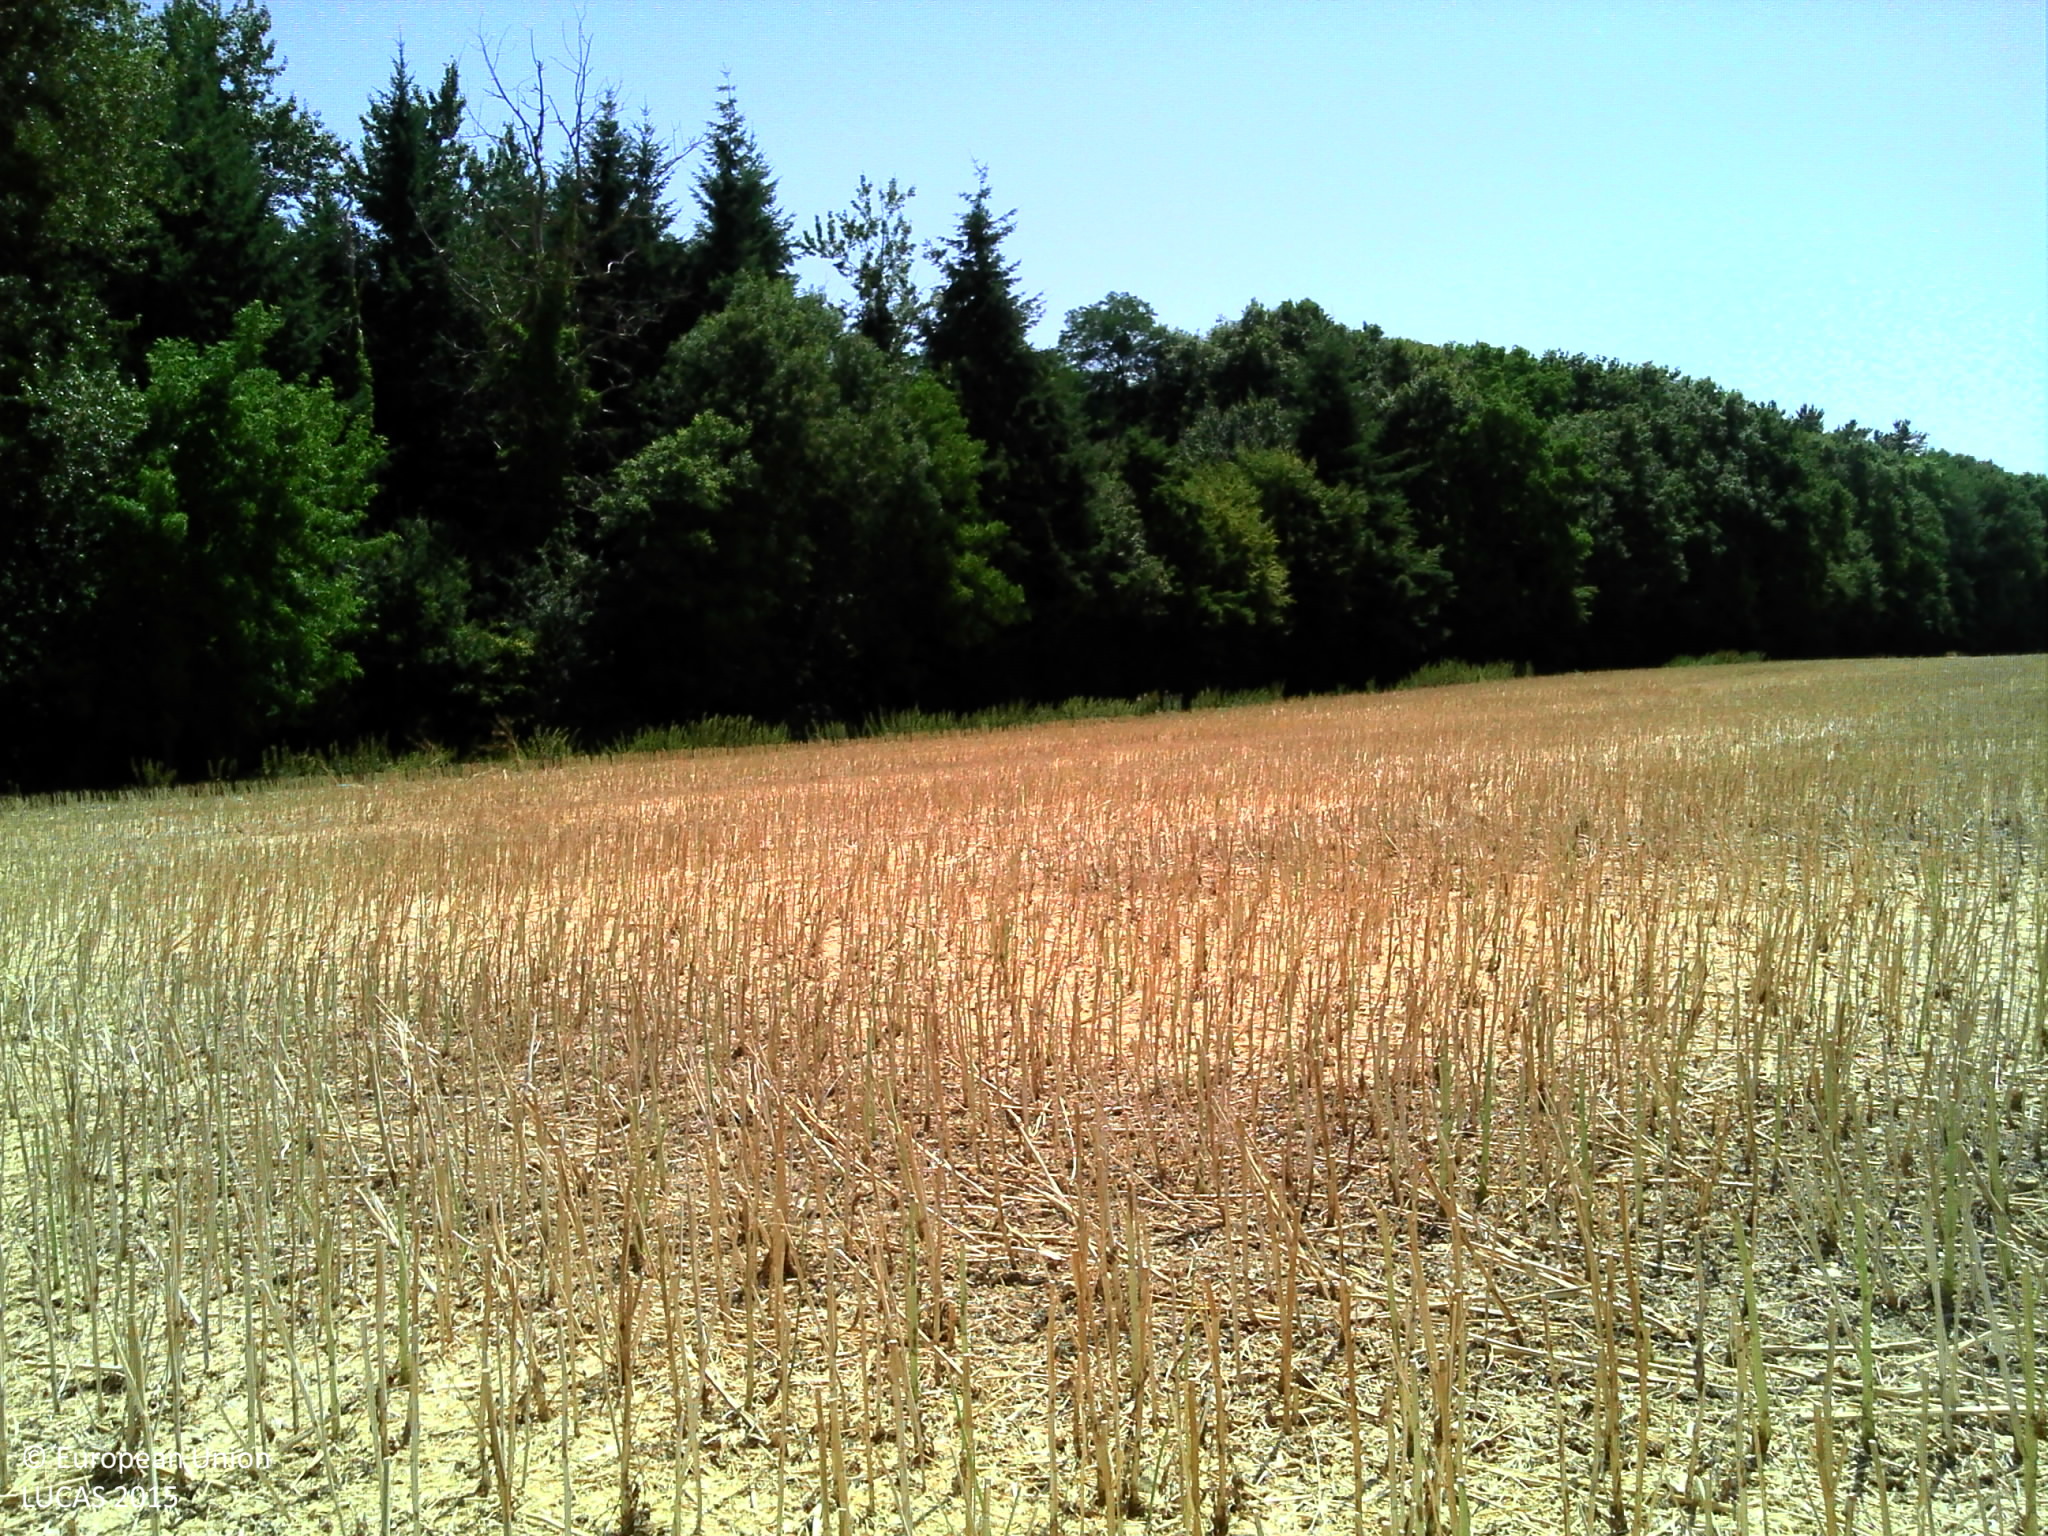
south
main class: Cropland
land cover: Rape and turnip rape
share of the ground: > 75 %
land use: Agriculture (excluding fallow land and kitchen gardens)
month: July
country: FR
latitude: 48.2377
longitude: 3.0314
